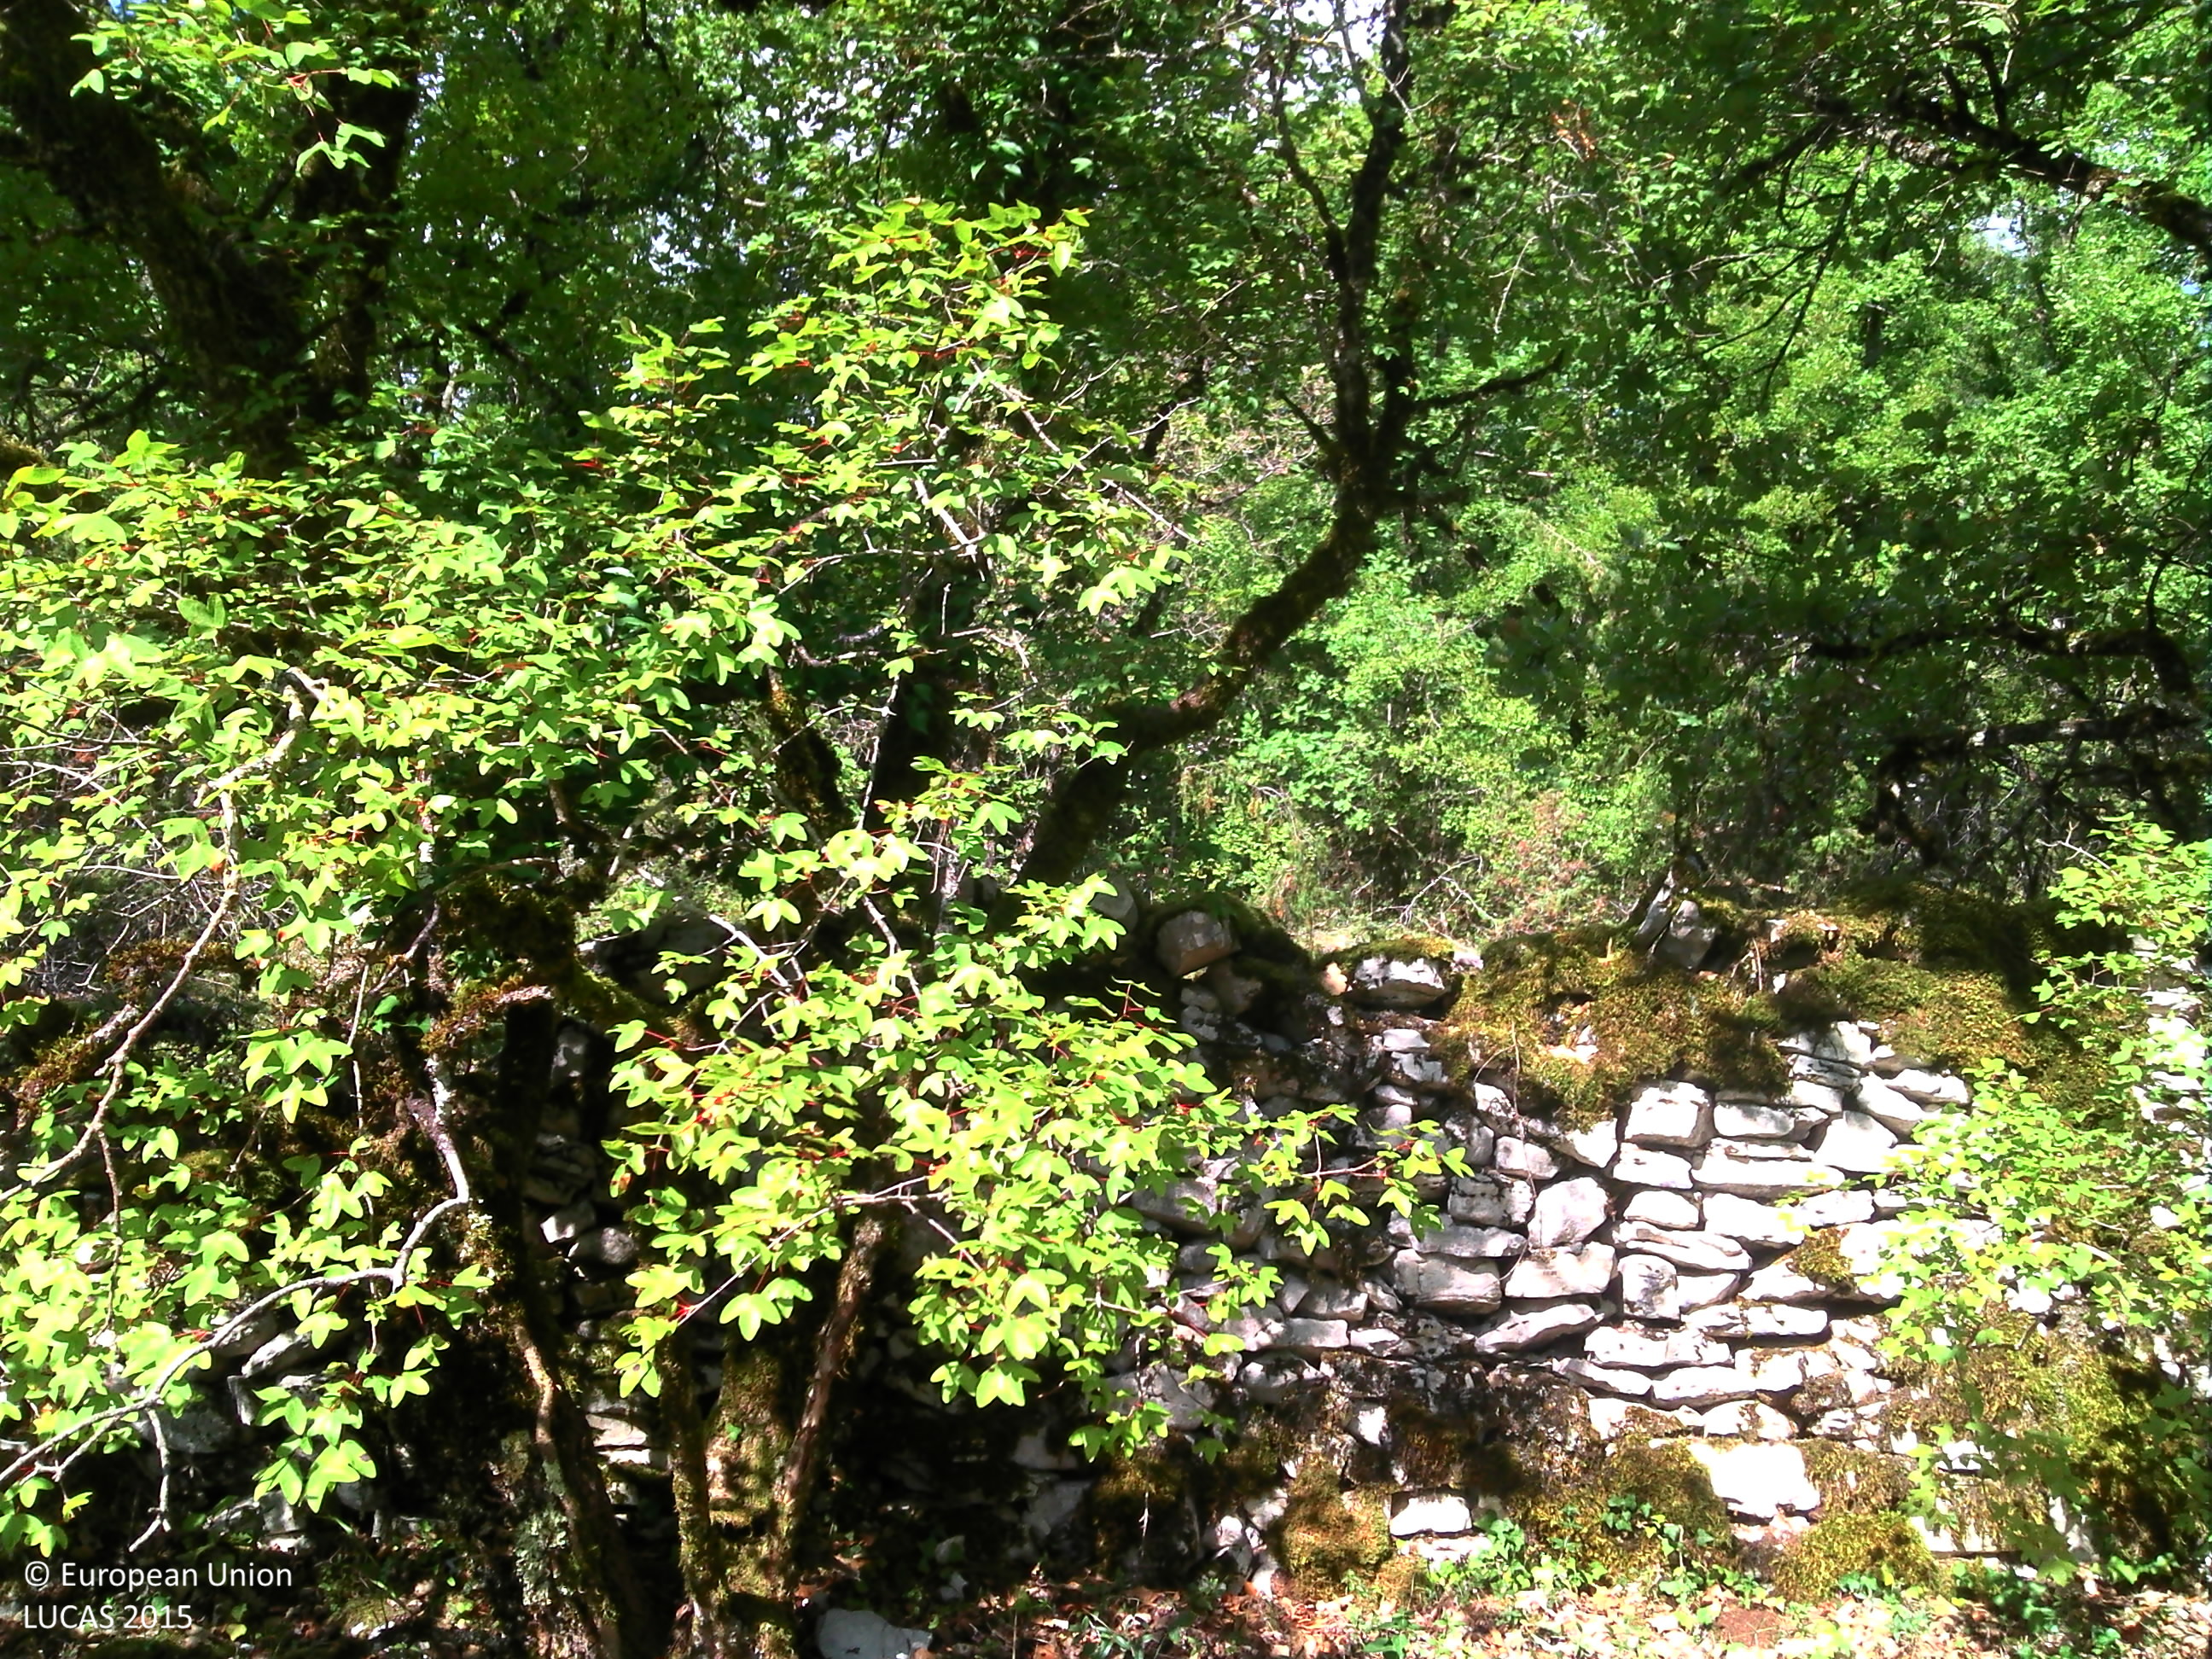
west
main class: Woodland
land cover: Broadleaved woodland
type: thermophilous deciduous forest
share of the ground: > 75 %
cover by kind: broadleaved forest trees 75 %, shrubs 10 %, unconsolidated bare surface 10 %, herbaceous plants 5 %
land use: Semi-natural and natural areas not in use
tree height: > 5 m
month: September
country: FR
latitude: 44.5892
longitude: 1.8244
